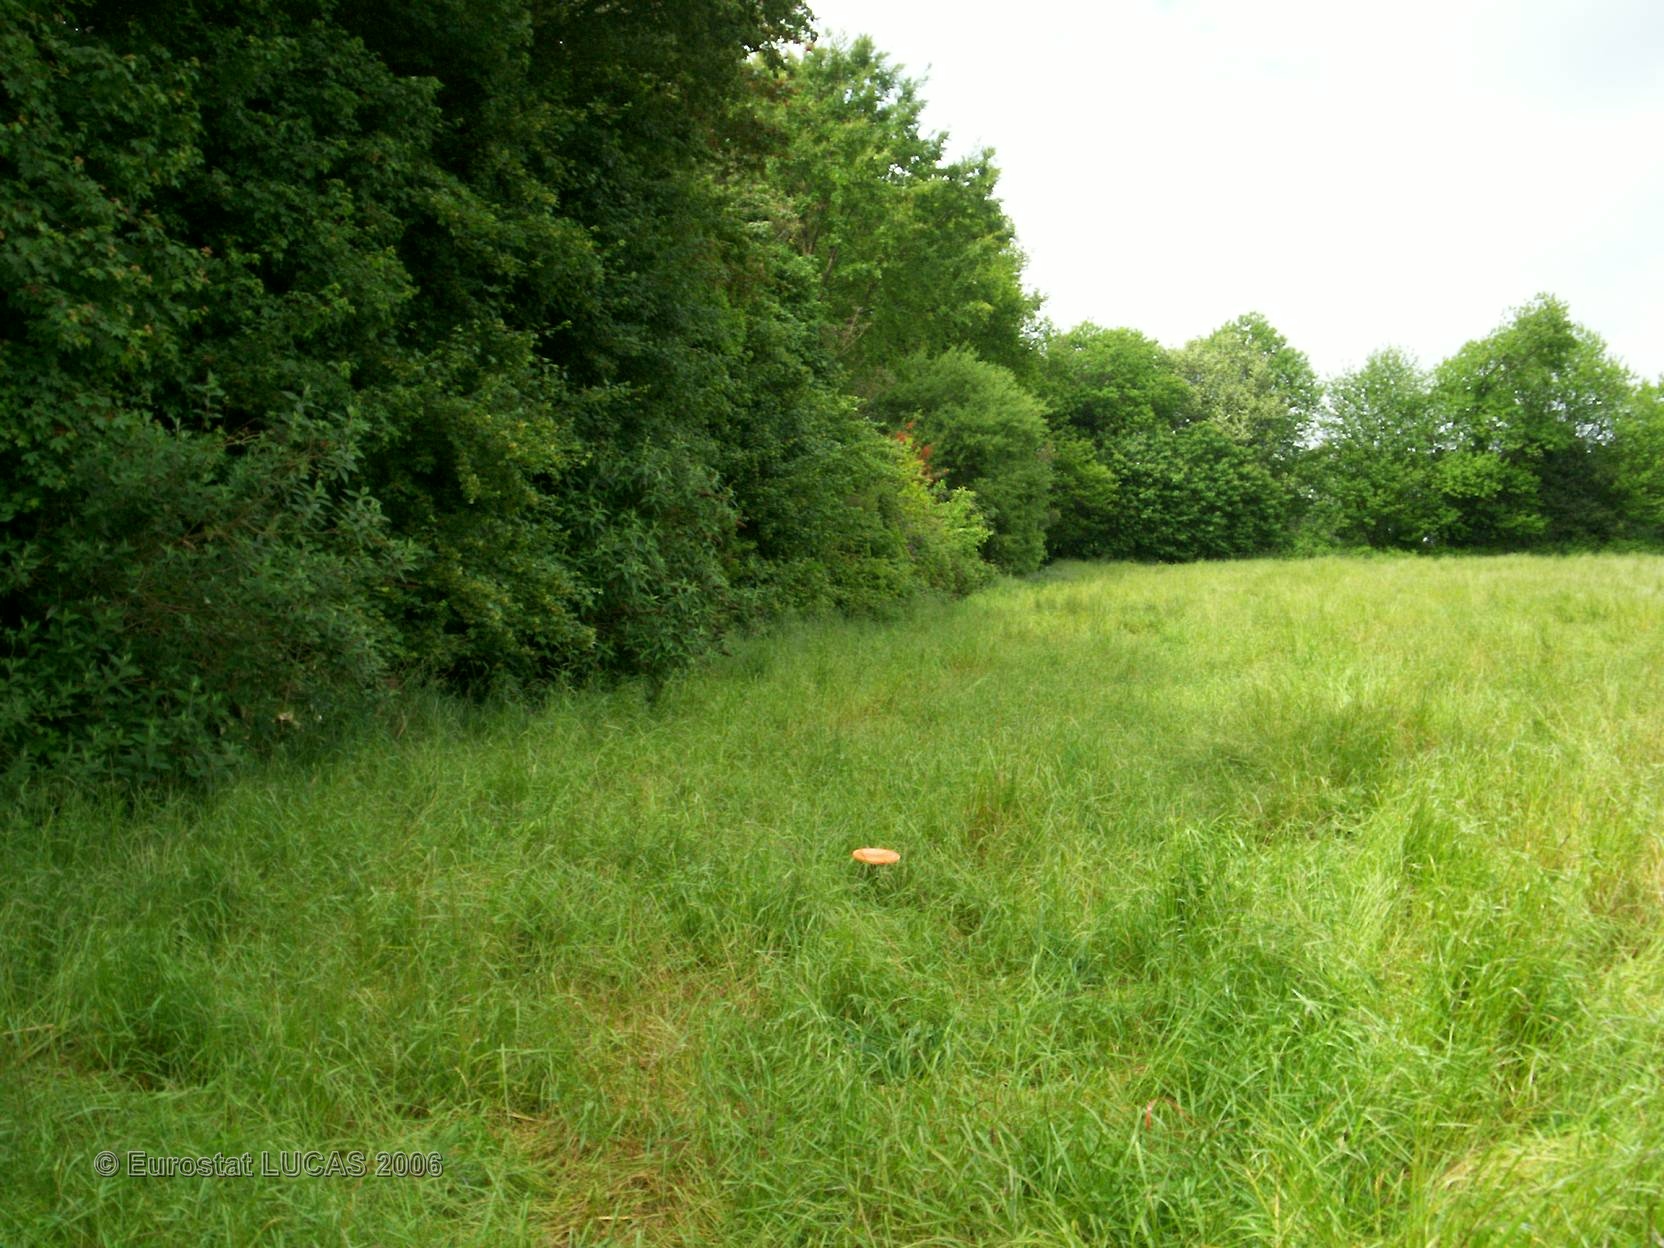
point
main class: Grassland
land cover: Grassland without tree/shrub cover
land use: Agriculture (excluding fallow land and kitchen gardens)
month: May
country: FR
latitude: 47.9145
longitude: -3.5240
